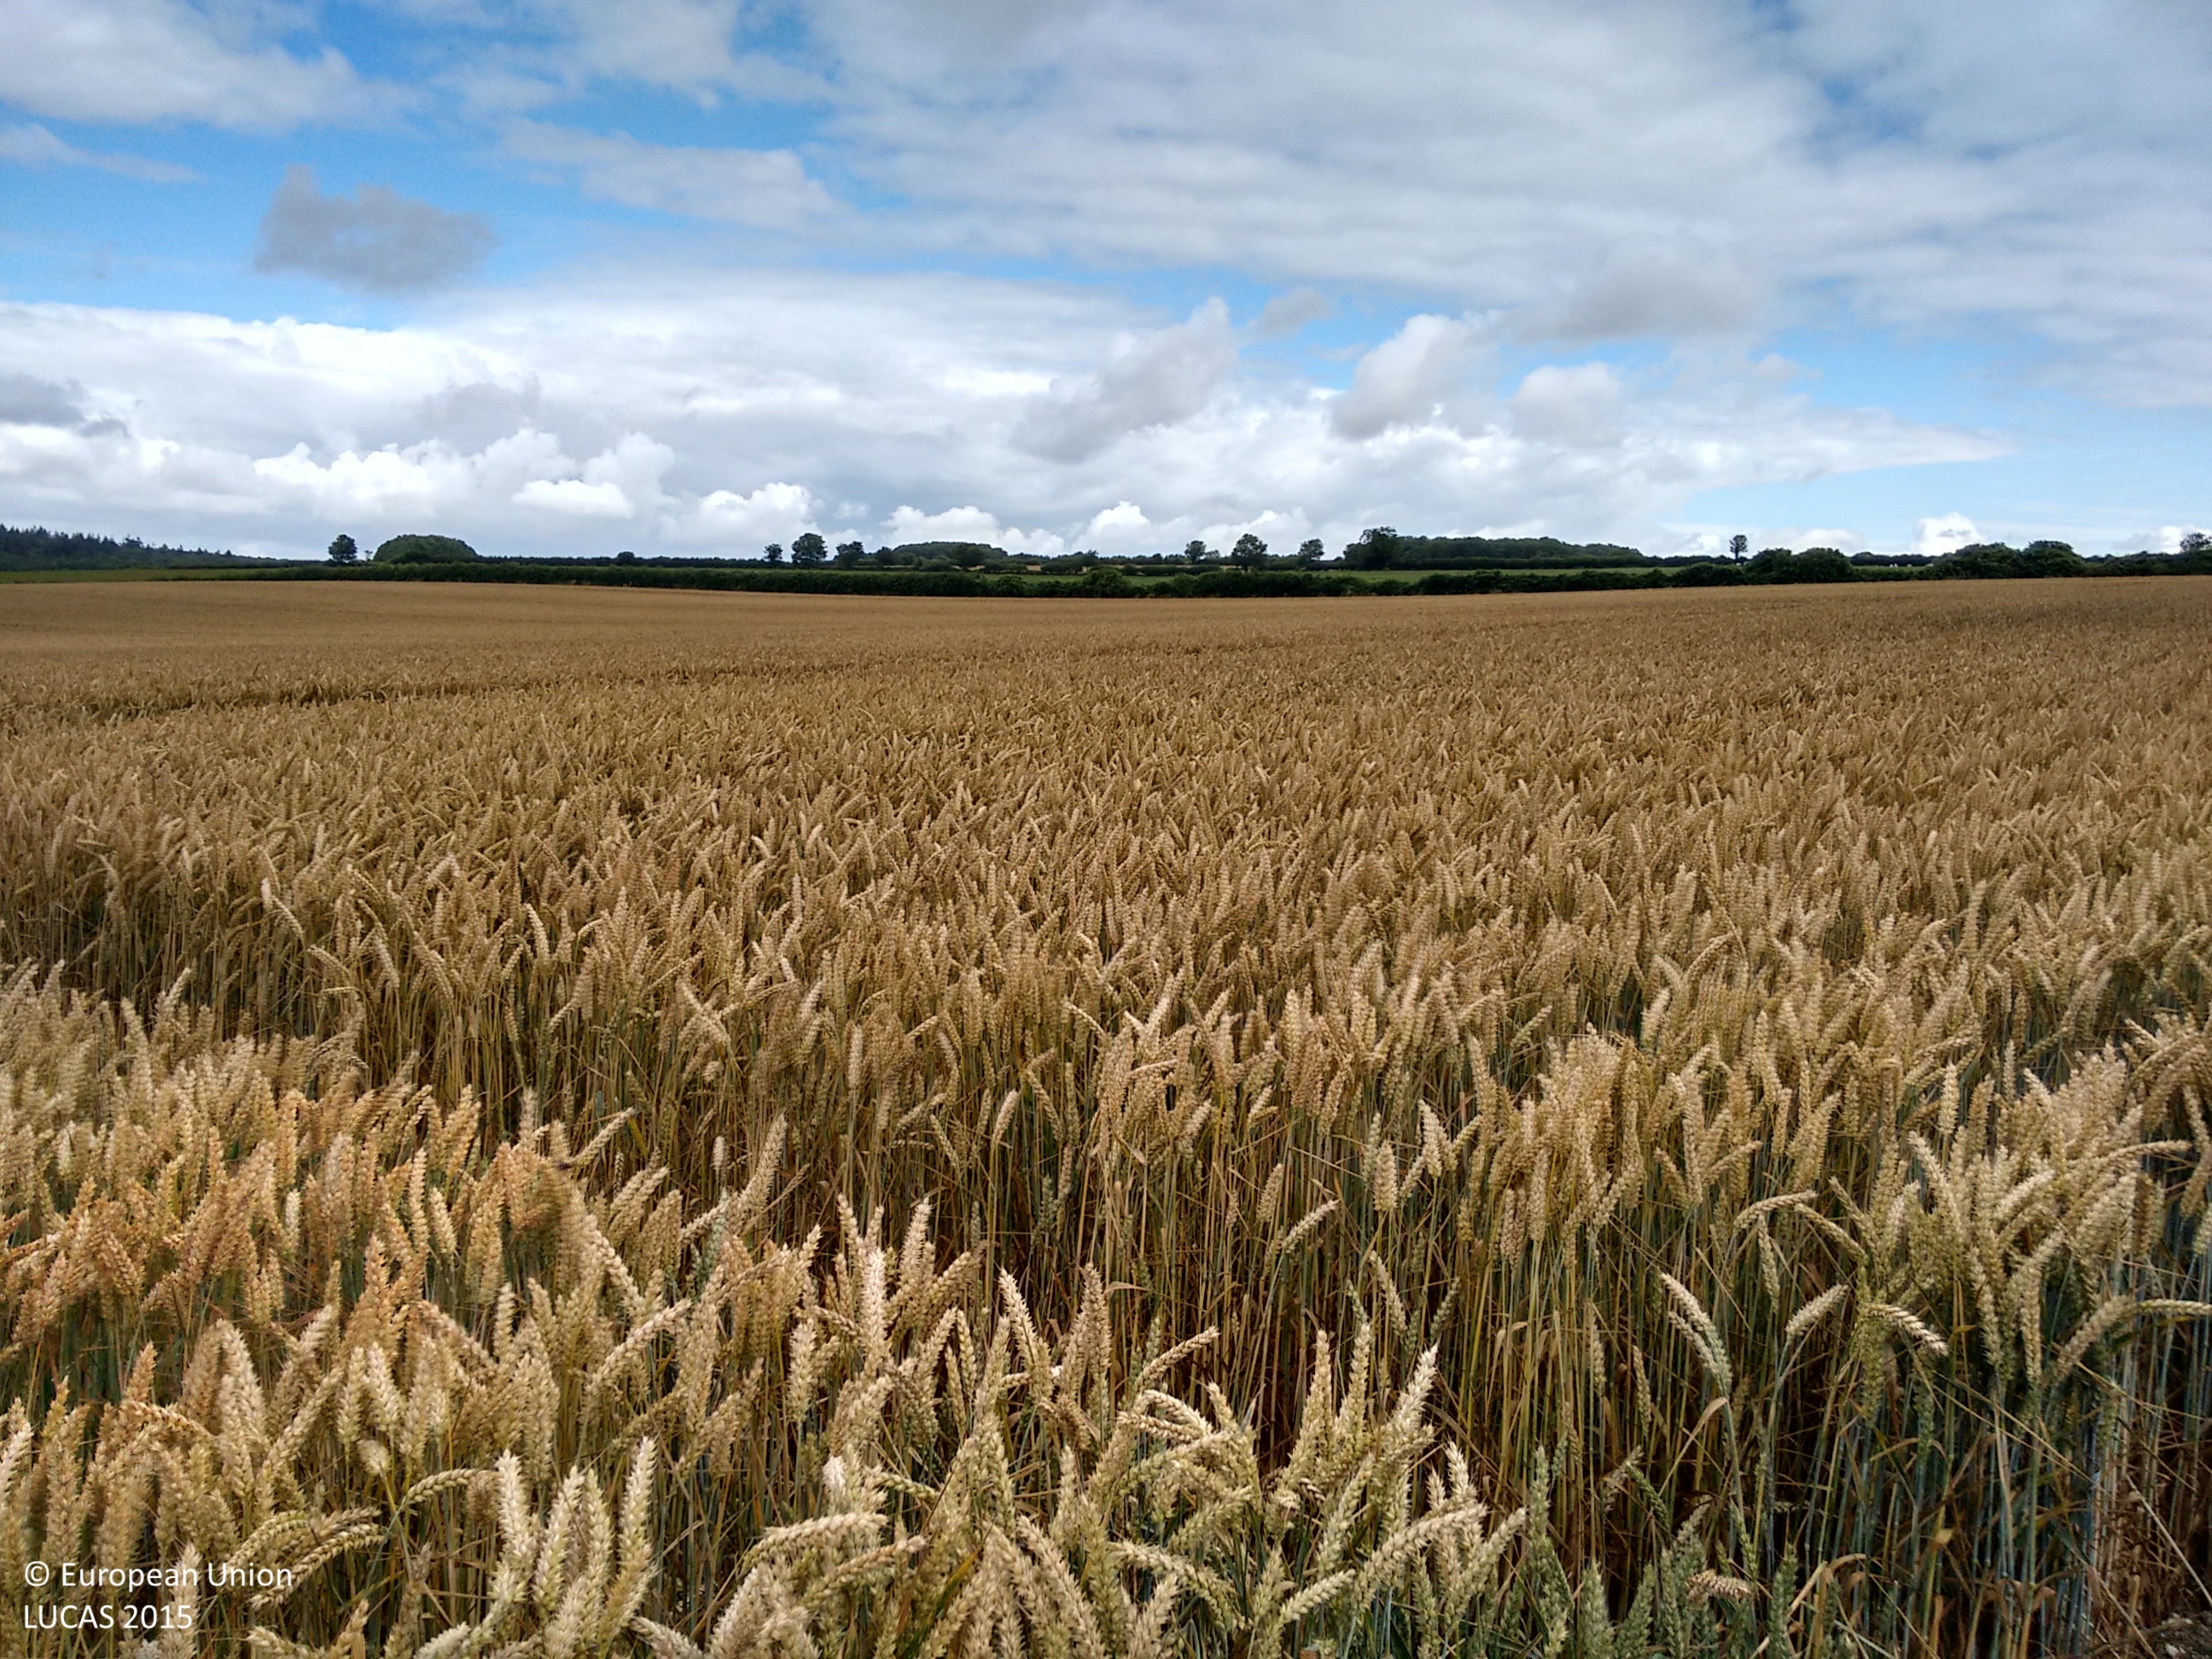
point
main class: Cropland
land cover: Common wheat
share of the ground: > 75 %
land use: Agriculture (excluding fallow land and kitchen gardens)
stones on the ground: 25 - 50 %
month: July
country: GB
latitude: 50.8652
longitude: -2.0943
